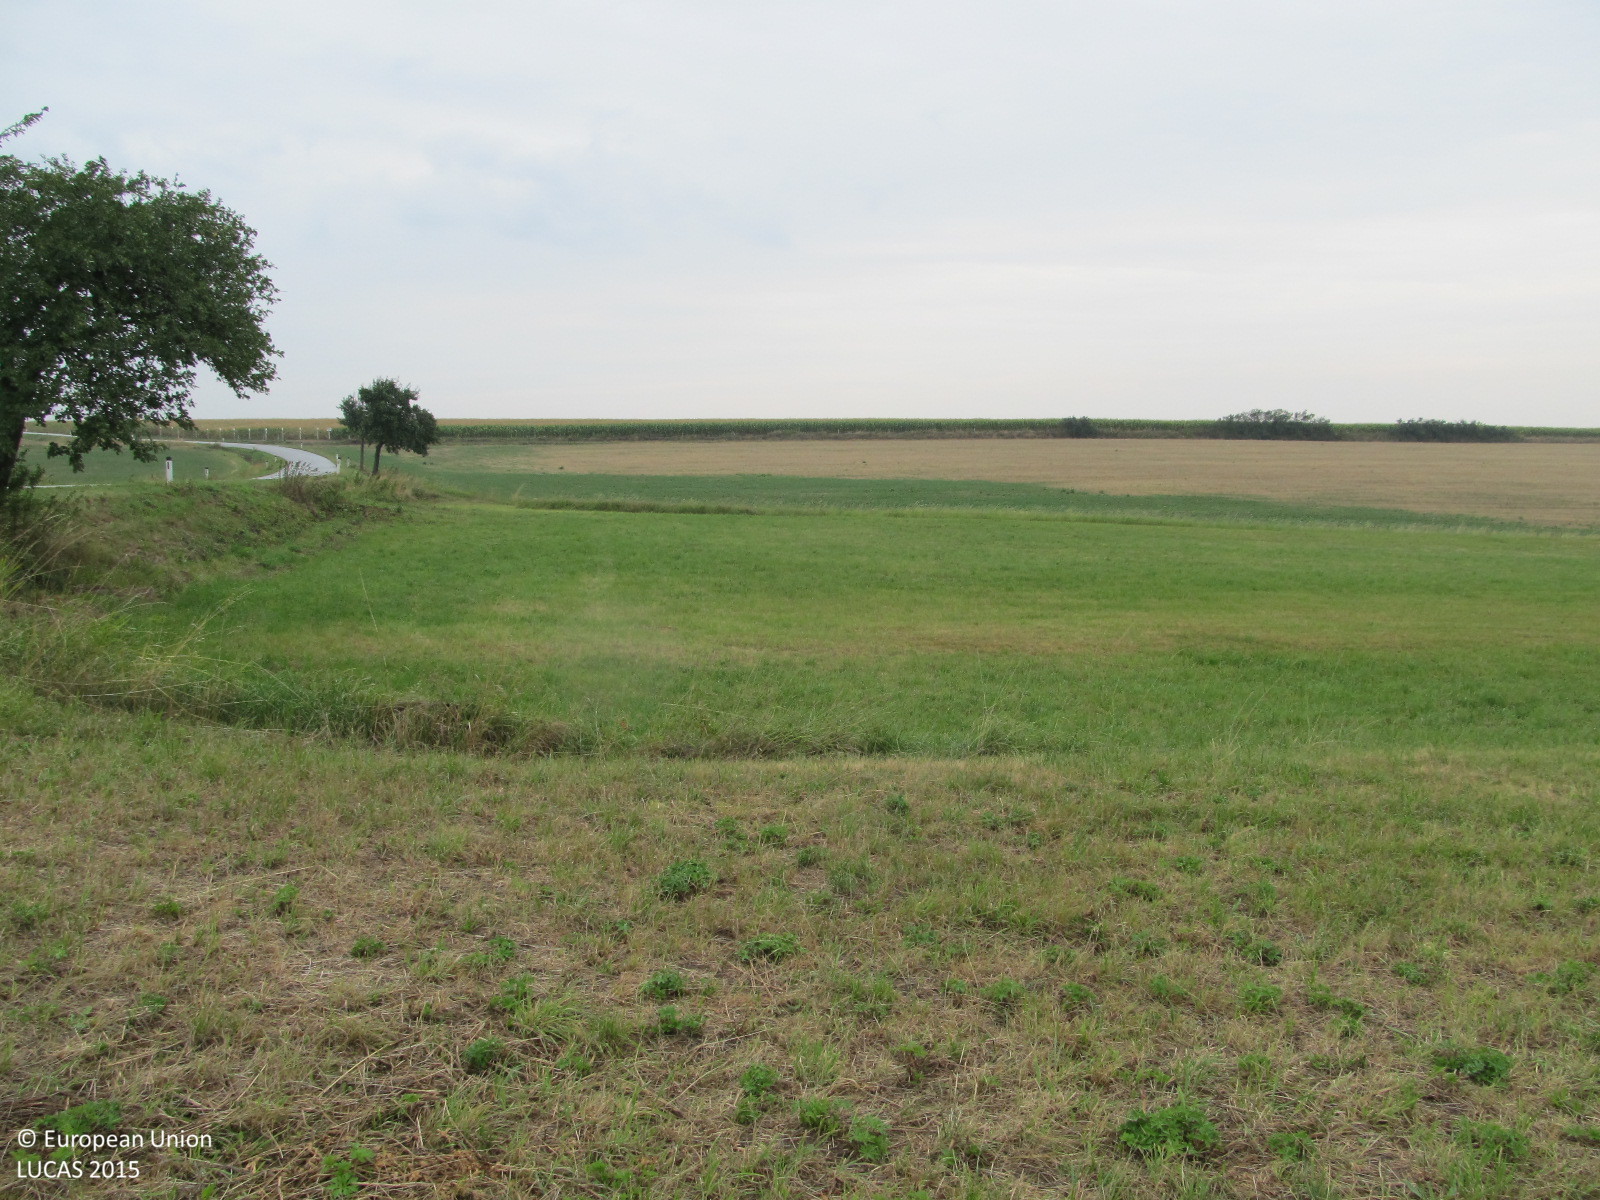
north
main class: Grassland
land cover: Grassland without tree/shrub cover
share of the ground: > 75 %
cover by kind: herbaceous plants 95 %, unconsolidated bare surface 5 %
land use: Agriculture (excluding fallow land and kitchen gardens)
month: August
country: AT
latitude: 48.8287
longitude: 15.4382
